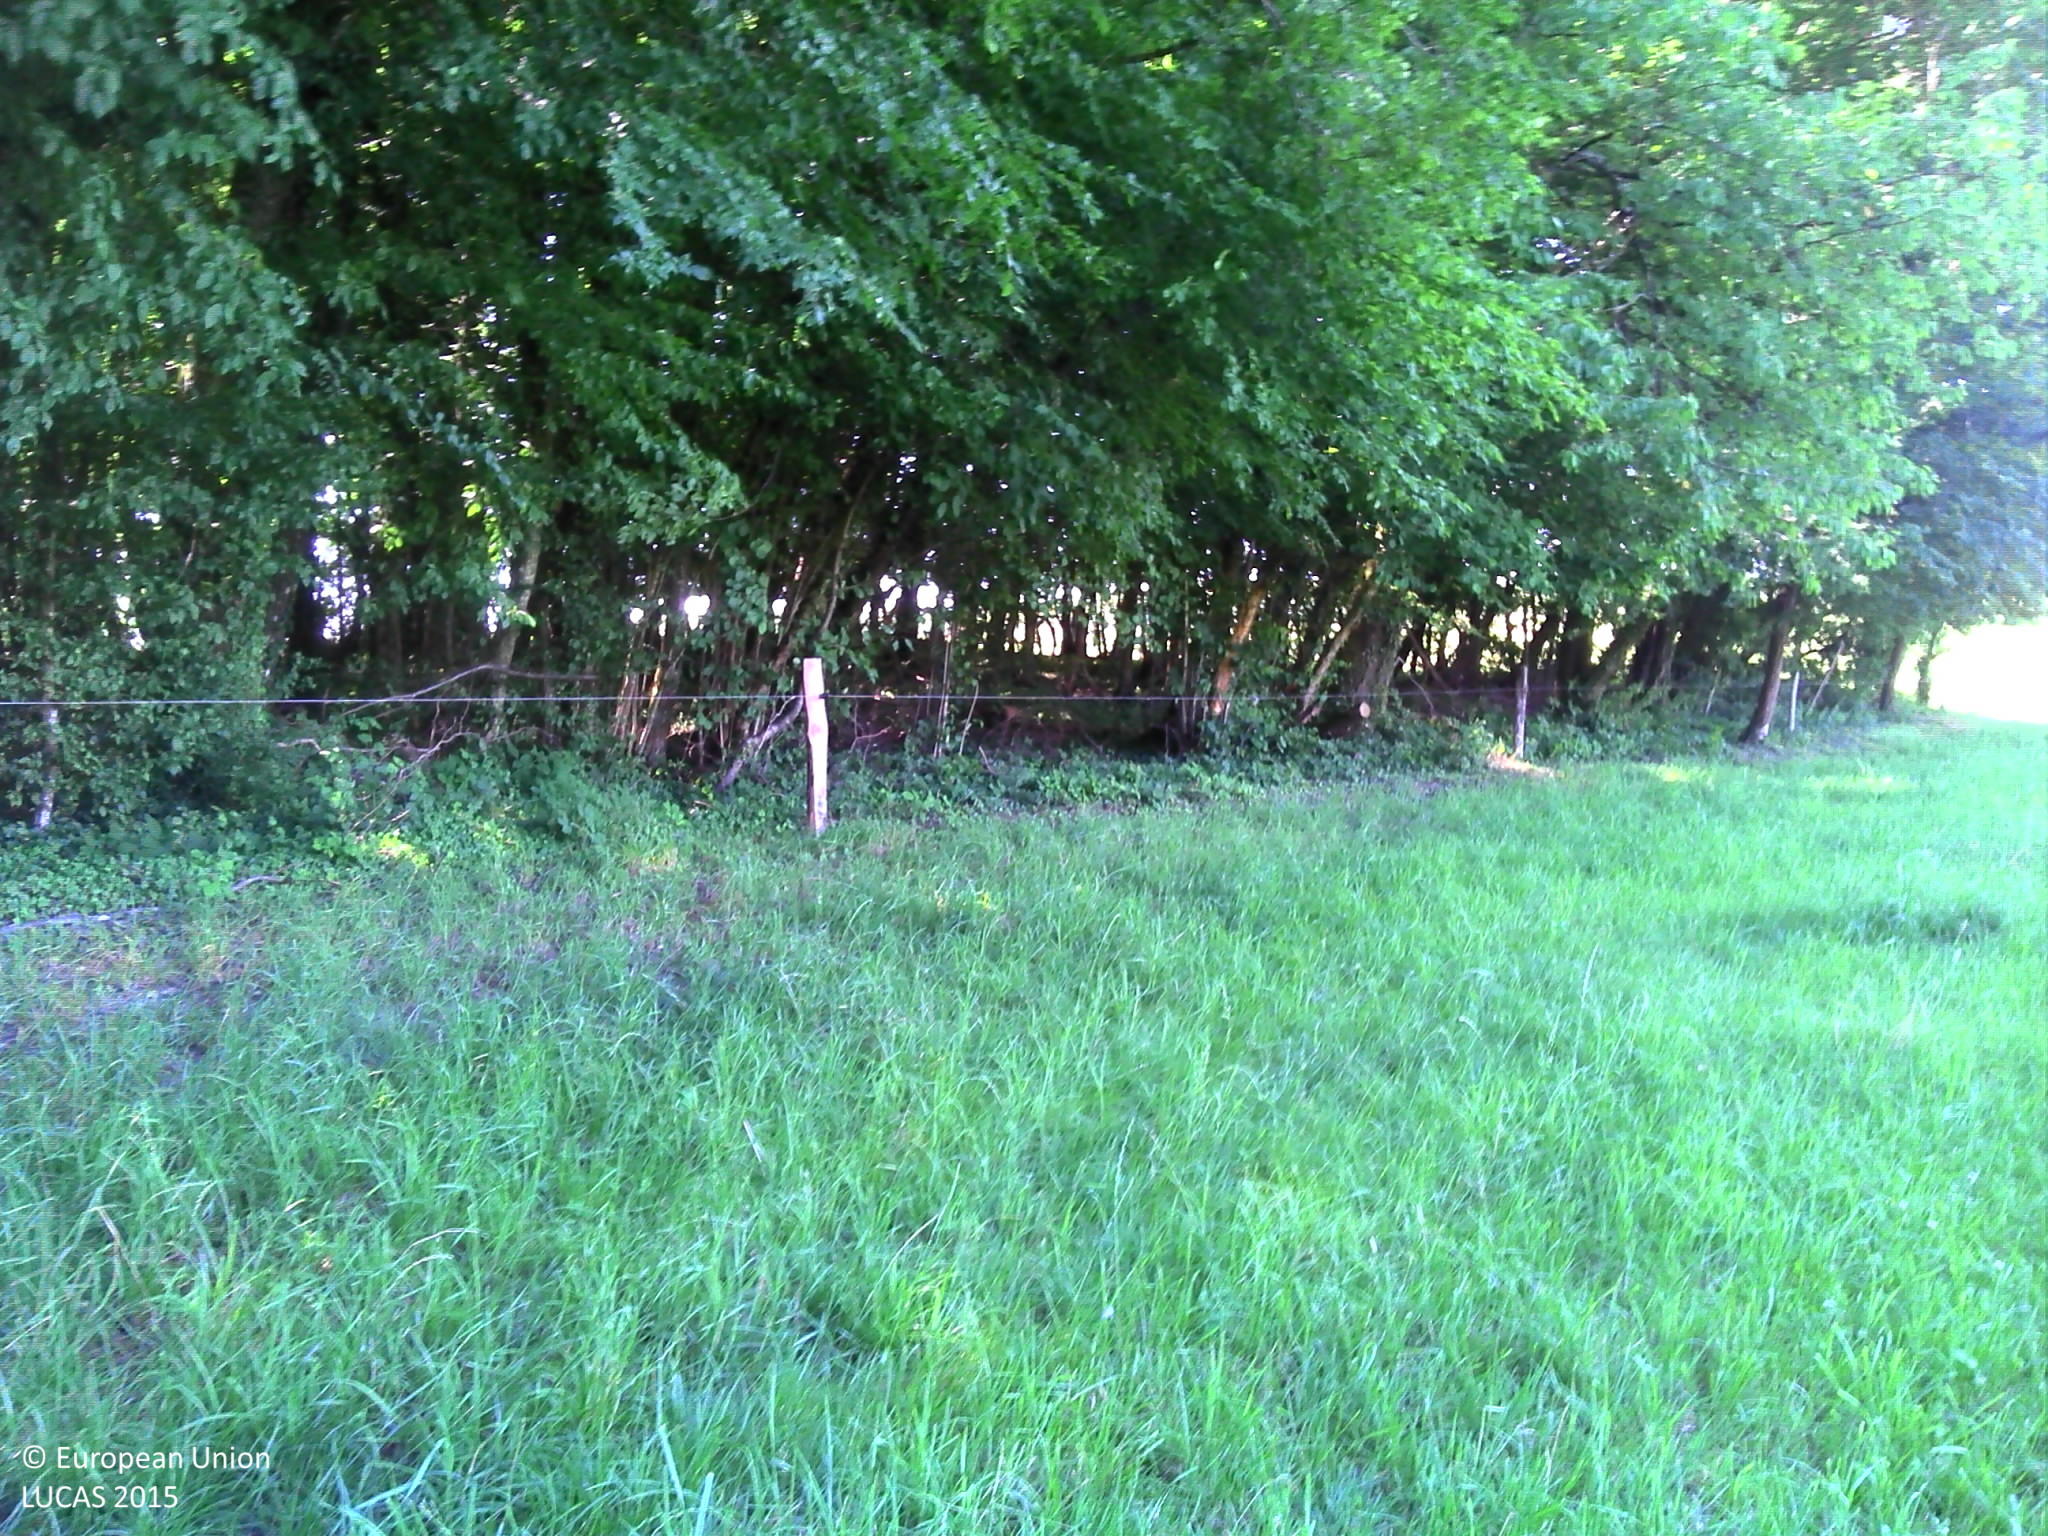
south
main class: Cropland
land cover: Temporary grasslands
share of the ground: > 75 %
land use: Agriculture (excluding fallow land and kitchen gardens)
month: June
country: FR
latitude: 47.4534
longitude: 6.1418
